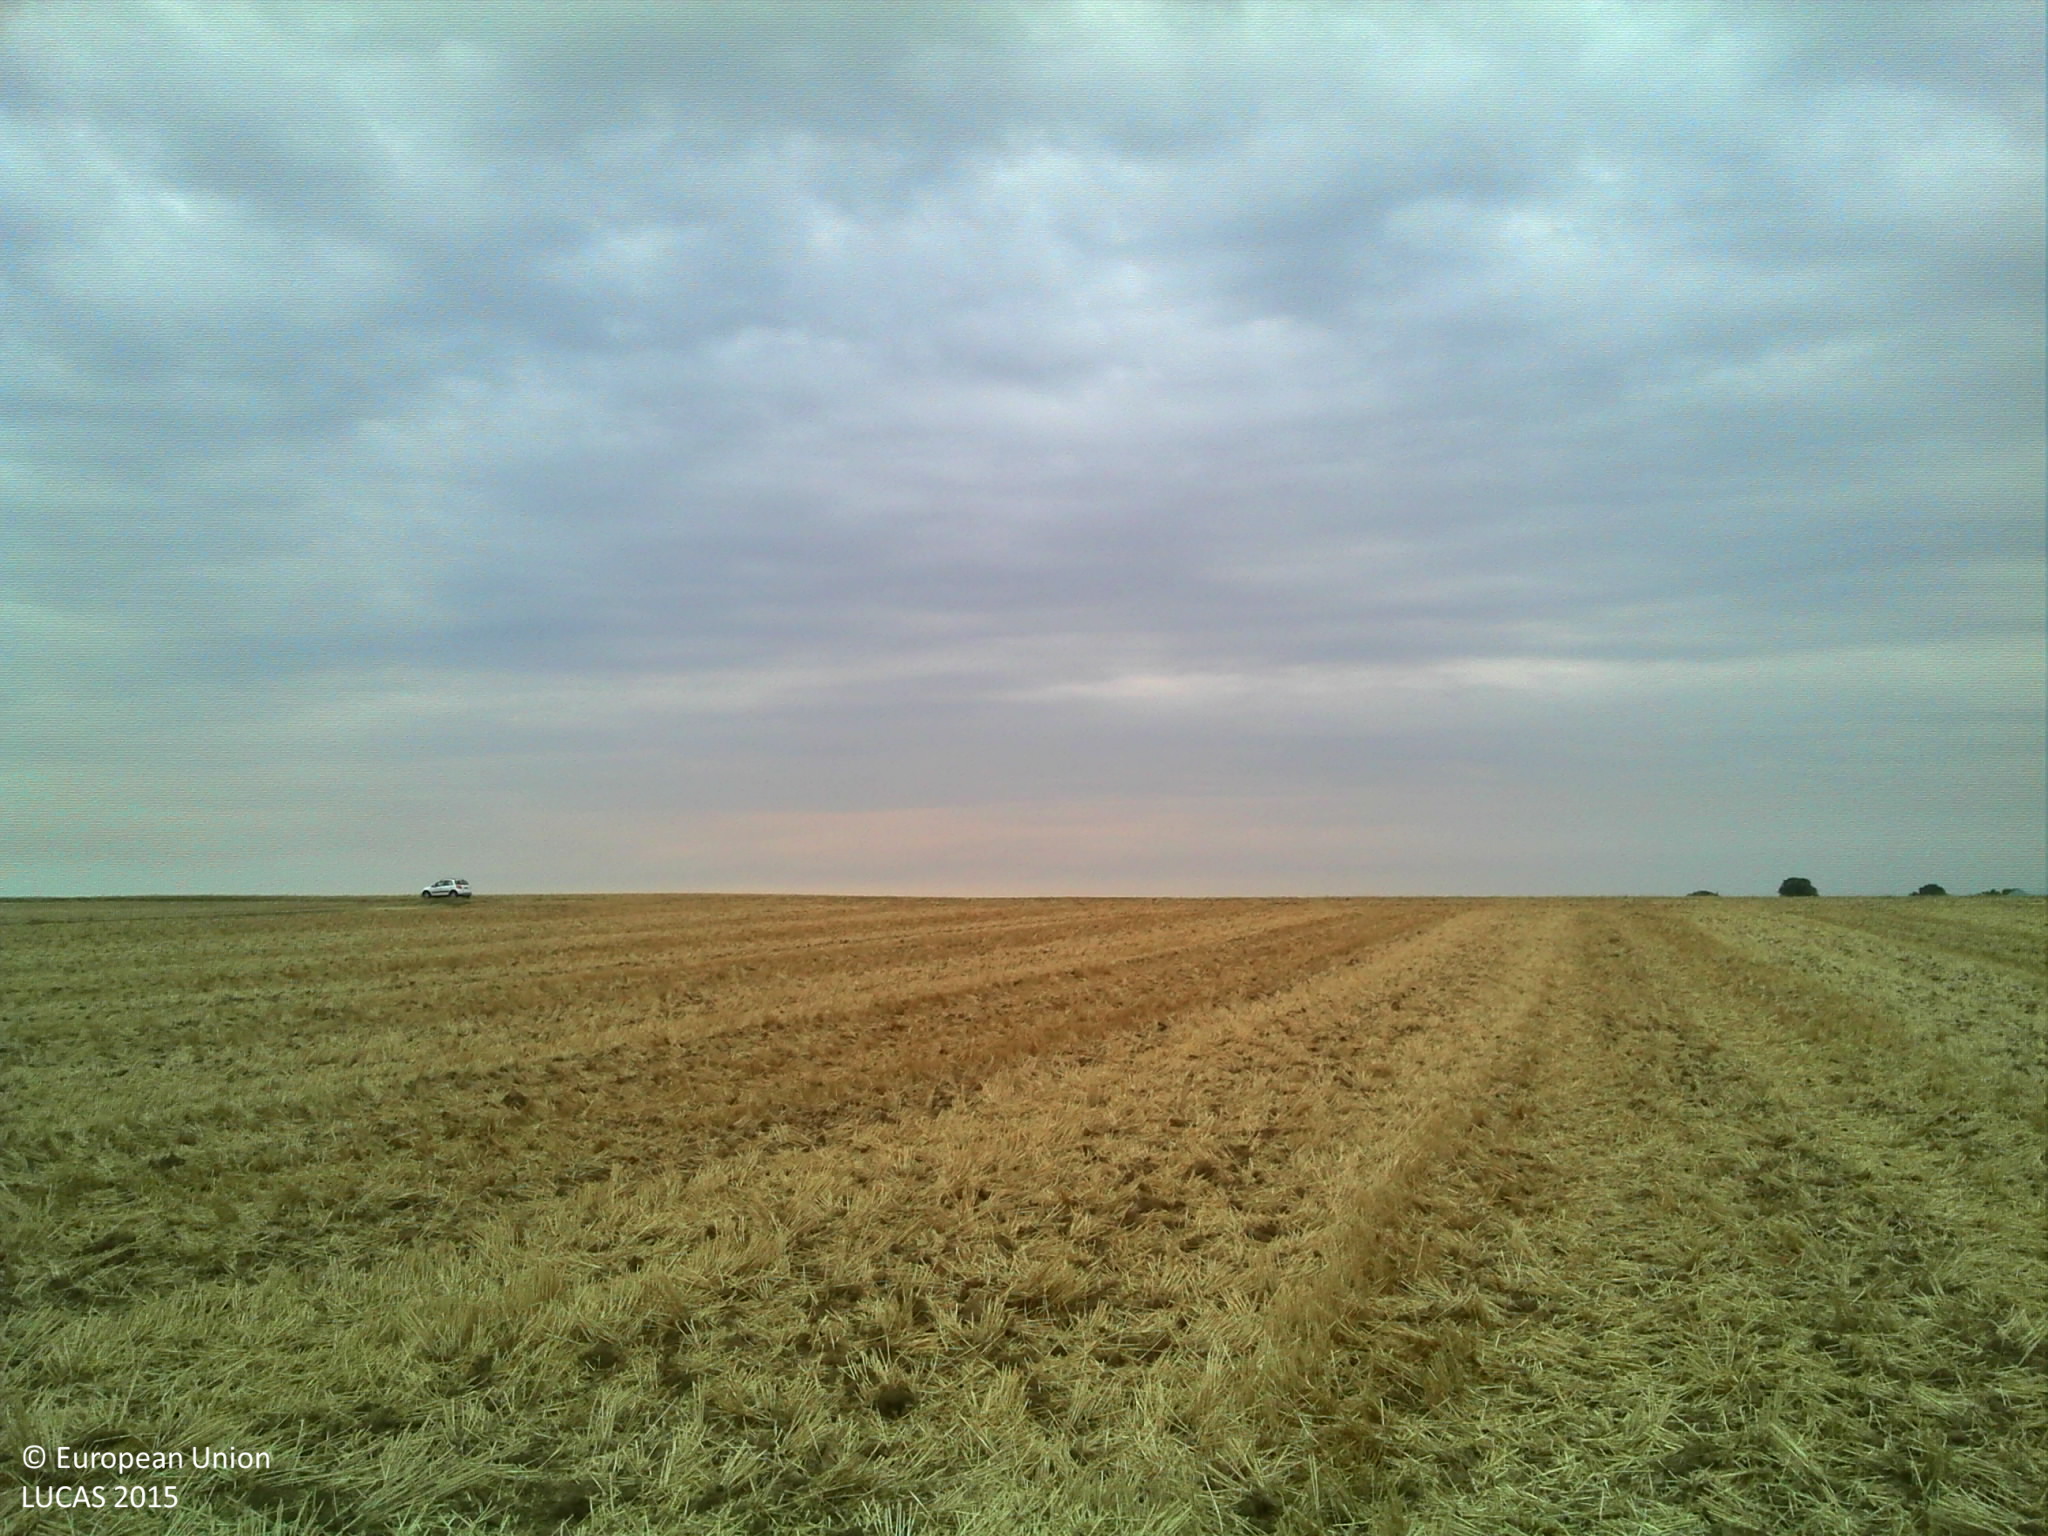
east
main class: Cropland
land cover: Common wheat
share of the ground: 10 - 25 %
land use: Agriculture (excluding fallow land and kitchen gardens)
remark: Harvested field
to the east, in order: Common wheat; Tracks; Common wheat; Tracks; Common wheat
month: August
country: FR
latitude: 48.2419
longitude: 2.5437
